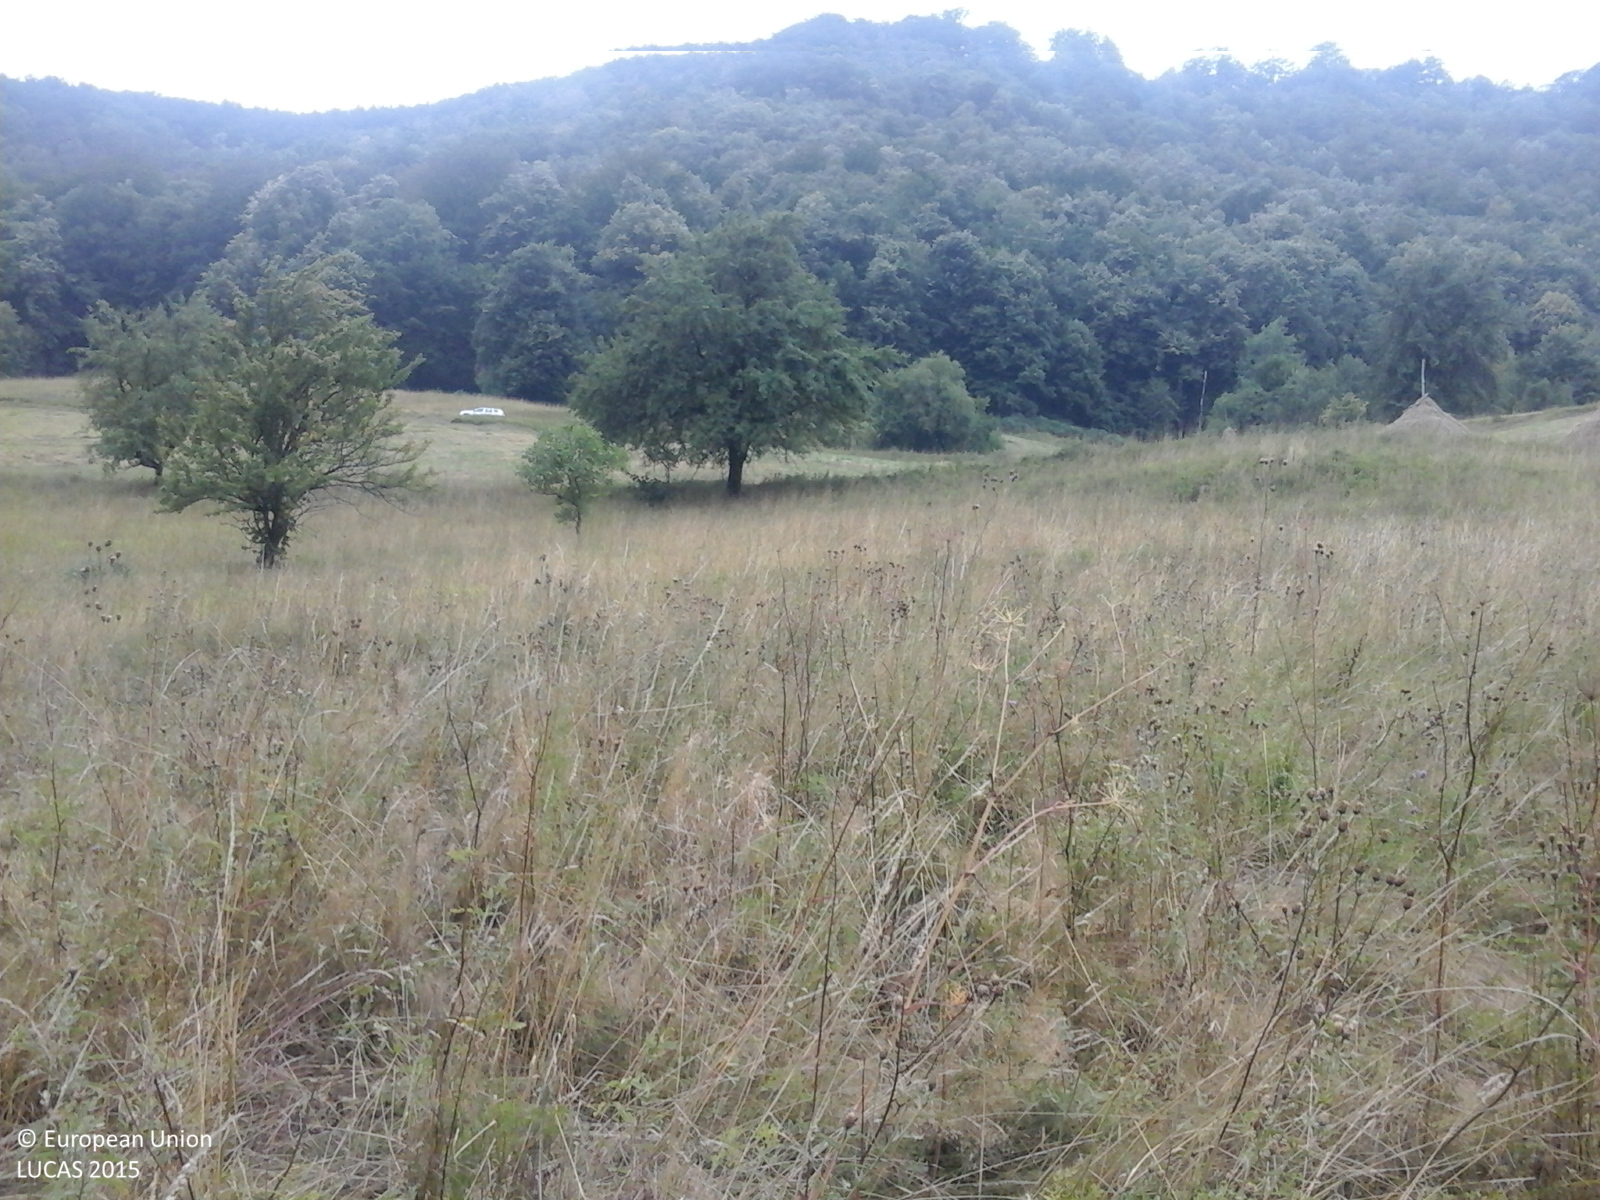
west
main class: Grassland
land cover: Grassland without tree/shrub cover
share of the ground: > 75 %
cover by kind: herbaceous plants 100 %
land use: Agriculture (excluding fallow land and kitchen gardens)
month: August
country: RO
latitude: 45.2420
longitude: 21.9477
